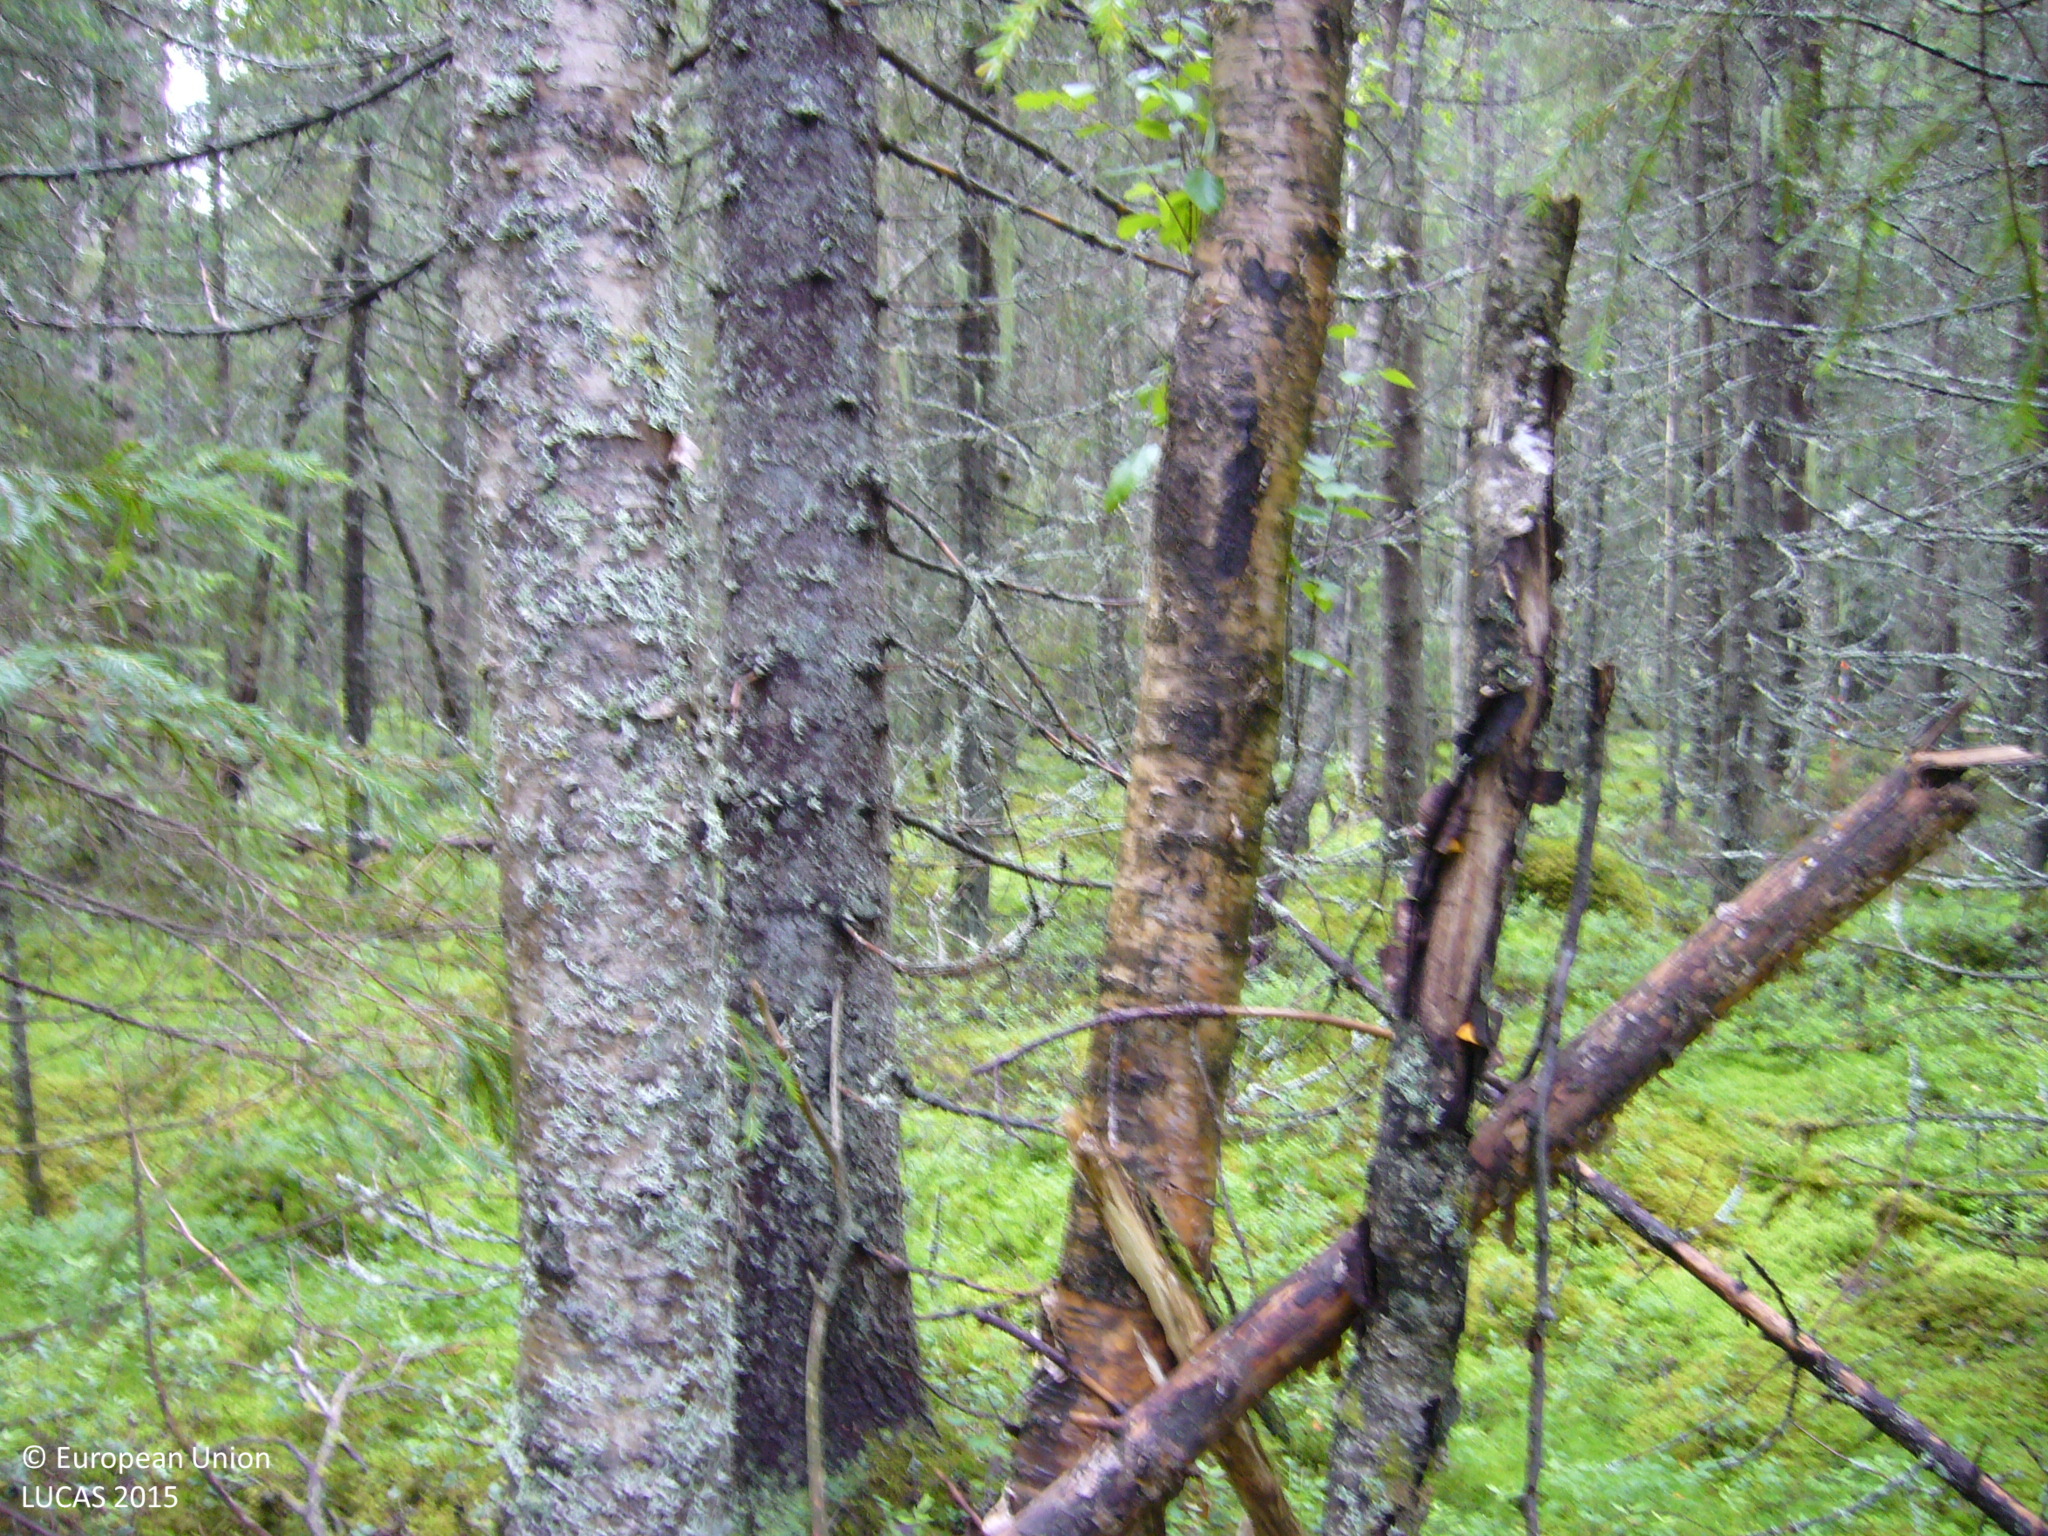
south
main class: Woodland
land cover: Spruce dominated mixed woodland
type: boreal forest
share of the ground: > 75 %
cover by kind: coniferous forest trees 50 %, broadleaved forest trees 30 %, shrubs 20 %
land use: Forestry
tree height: > 5 m
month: July
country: FI
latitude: 63.8832
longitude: 25.5523
